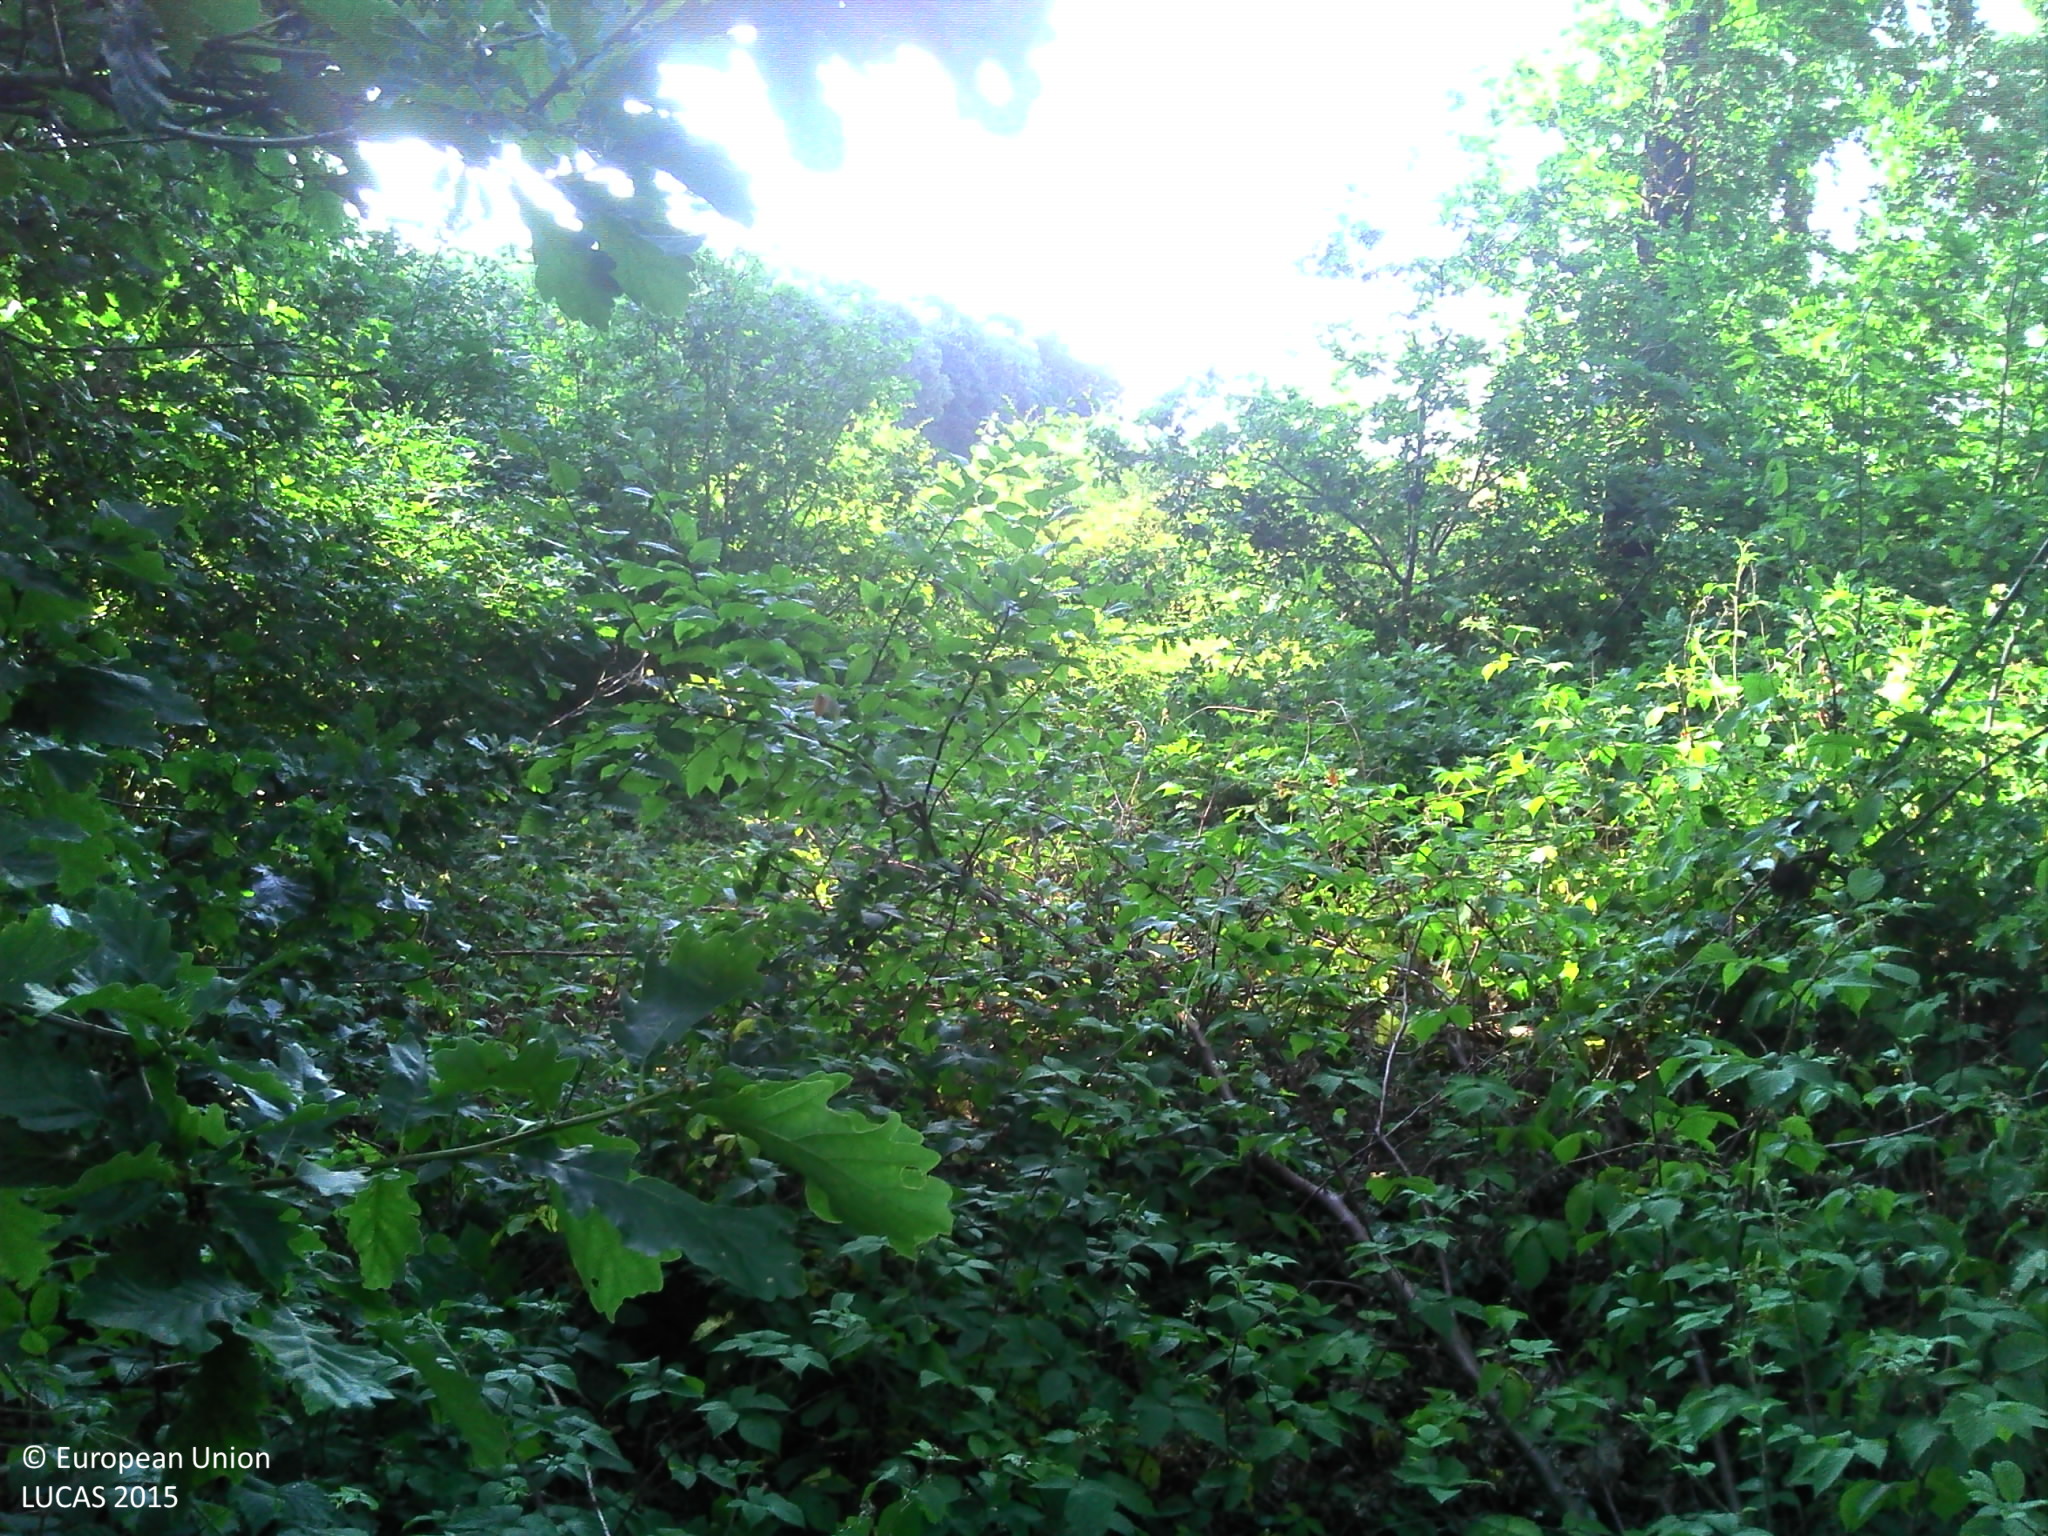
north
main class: Woodland
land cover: Broadleaved woodland
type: mesophytic deciduous forest
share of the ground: > 75 %
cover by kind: broadleaved forest trees 70 %, herbaceous plants 30 %
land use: Forestry
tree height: > 5 m
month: July
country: FR
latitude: 48.8918
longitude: 1.2927
